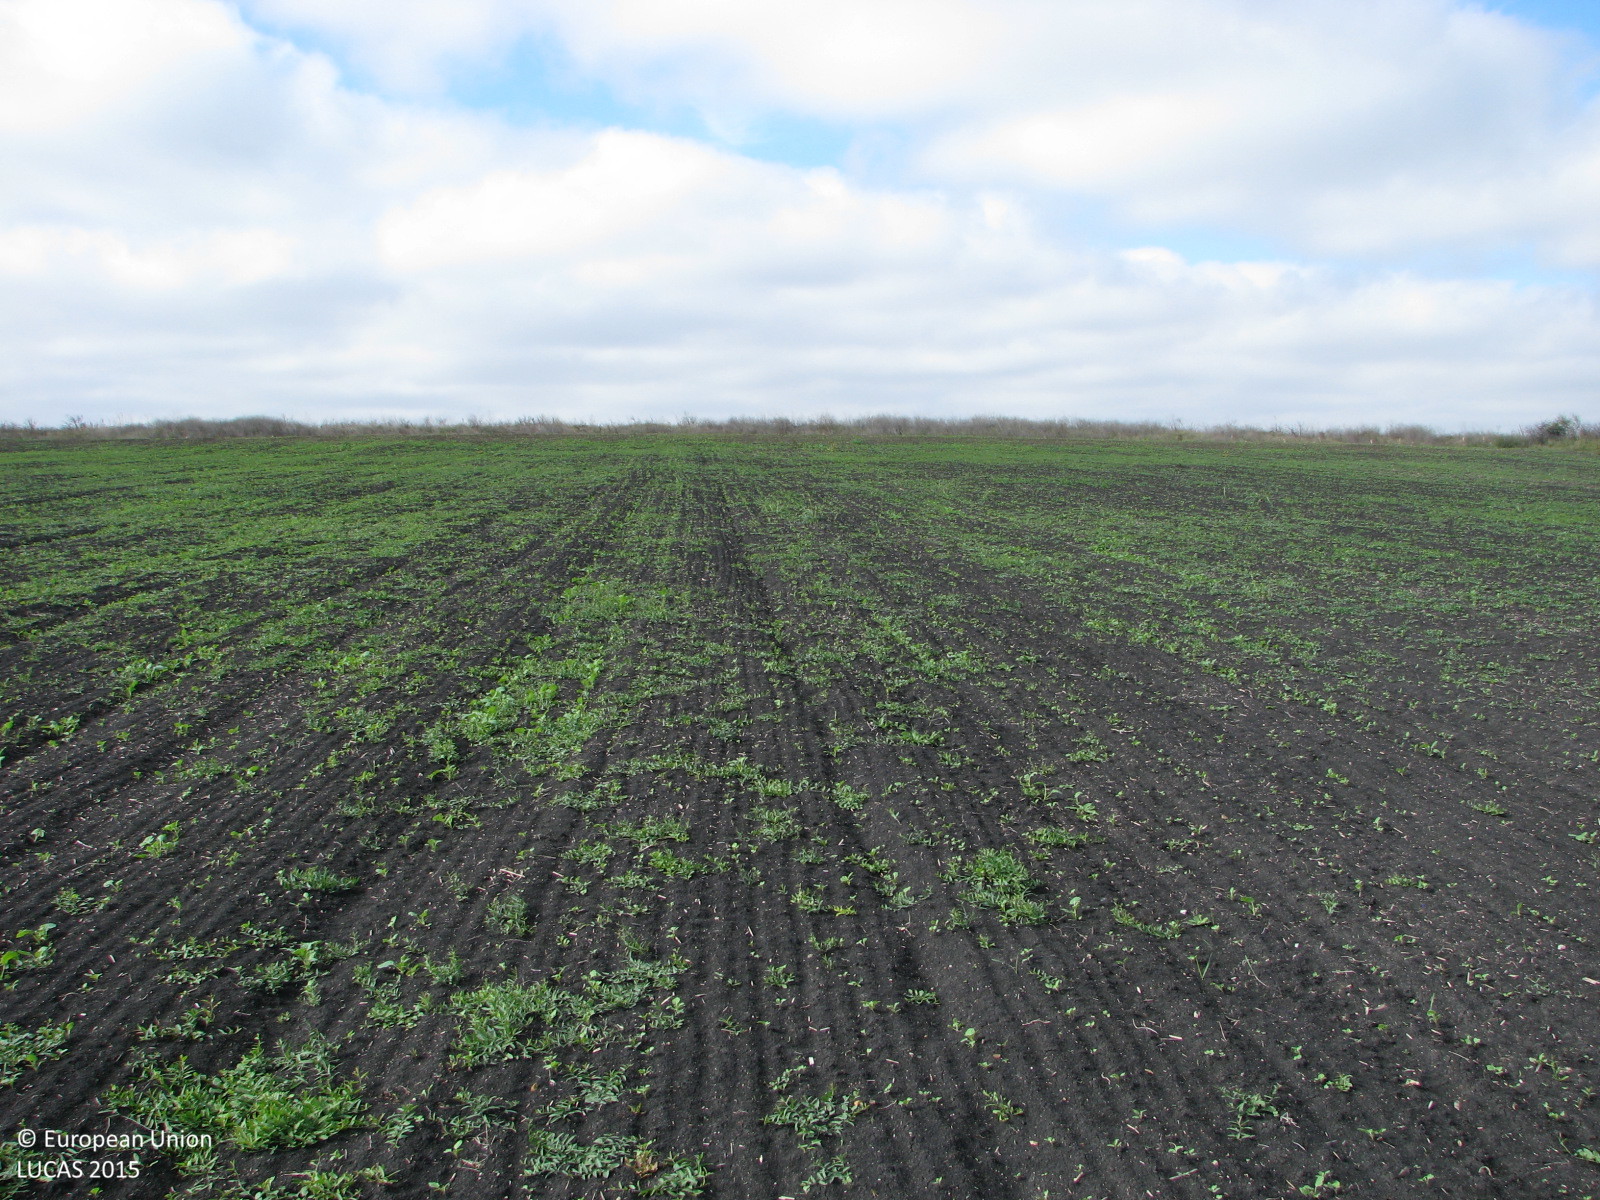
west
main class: Grassland
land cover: Spontaneously vegetated surfaces
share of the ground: 25 - 50 %
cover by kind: consolidated bare surface 70 %, herbaceous plants 30 %
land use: Agriculture (excluding fallow land and kitchen gardens)
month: October
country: BG
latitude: 42.3794
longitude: 26.4740
